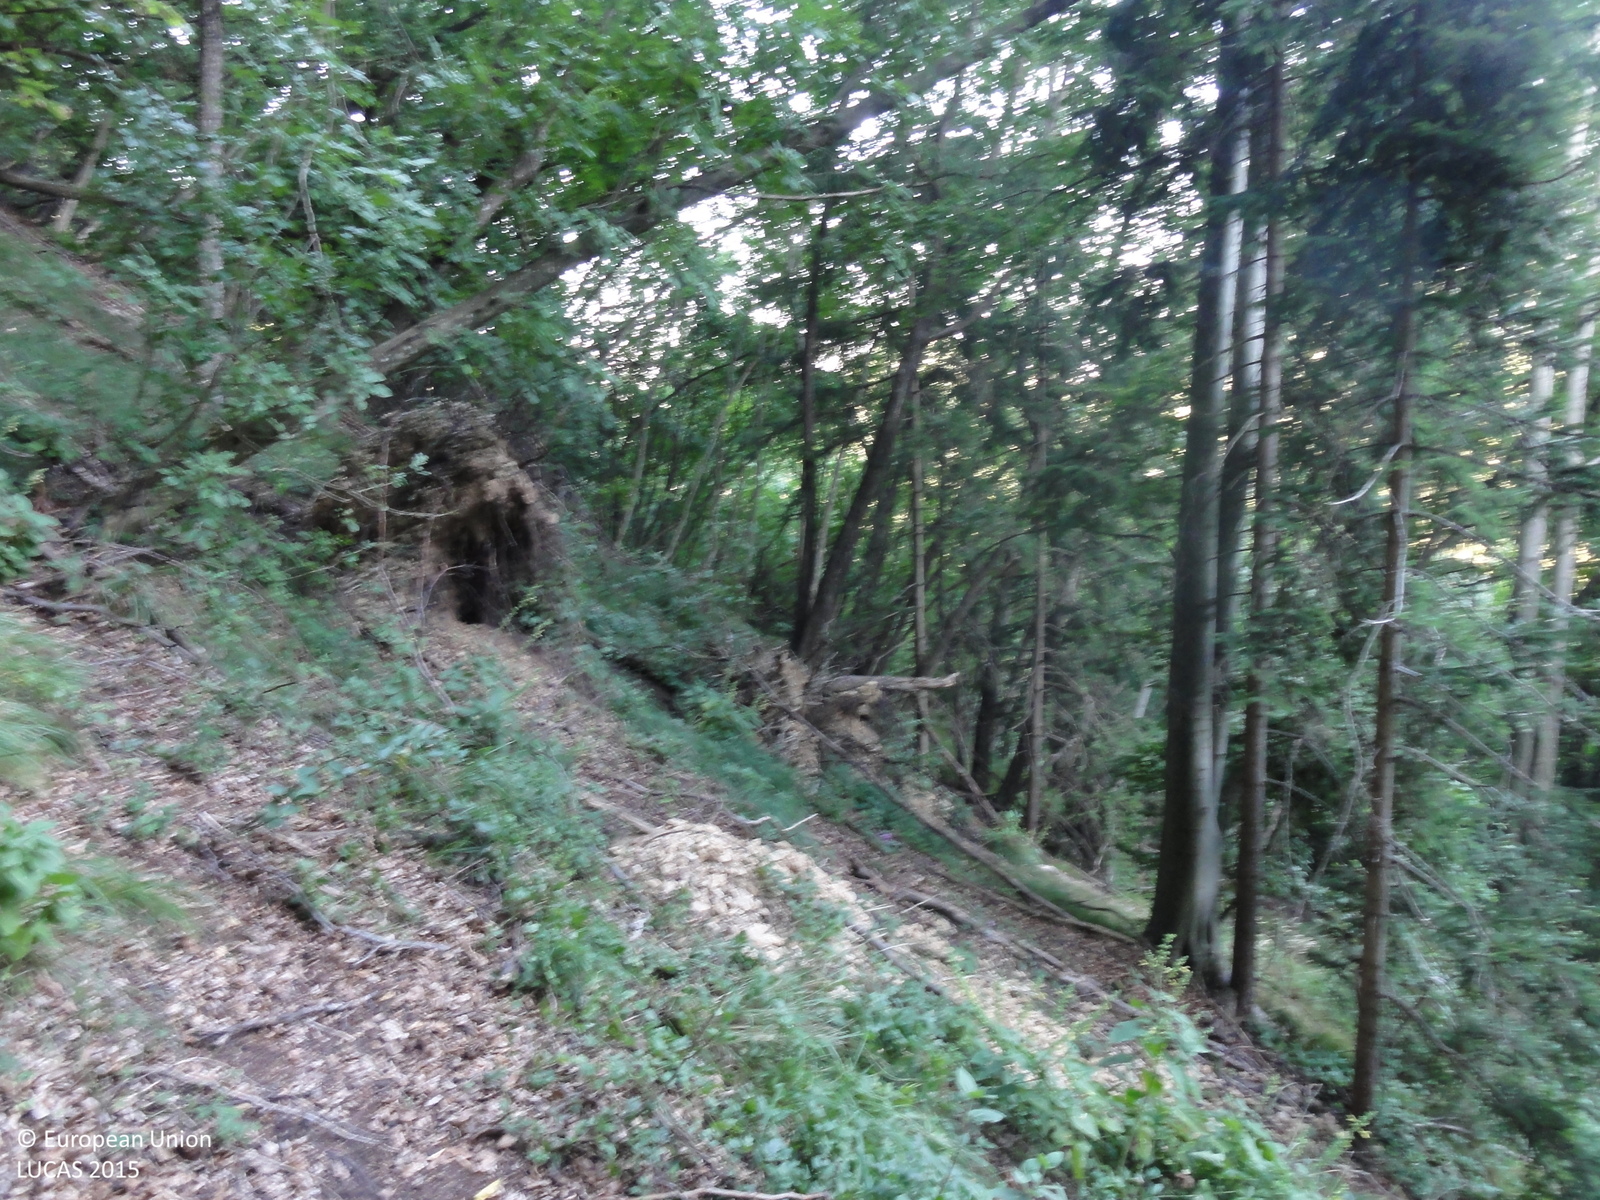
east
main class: Woodland
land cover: Broadleaved woodland
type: beech forest
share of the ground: > 75 %
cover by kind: broadleaved forest trees 90 %, coniferous forest trees 10 %
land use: Forestry
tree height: > 5 m
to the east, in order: Broadleaved woodland; Spruce dominated mixed woodland; Broadleaved woodland; Fences; Broadleaved woodland; Artificial constructions in urban areas; Apple fruit; Artificial constructions in urban areas; Grassland without tree/shrub cover
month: August
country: SI
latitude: 46.0682
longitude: 15.0779
